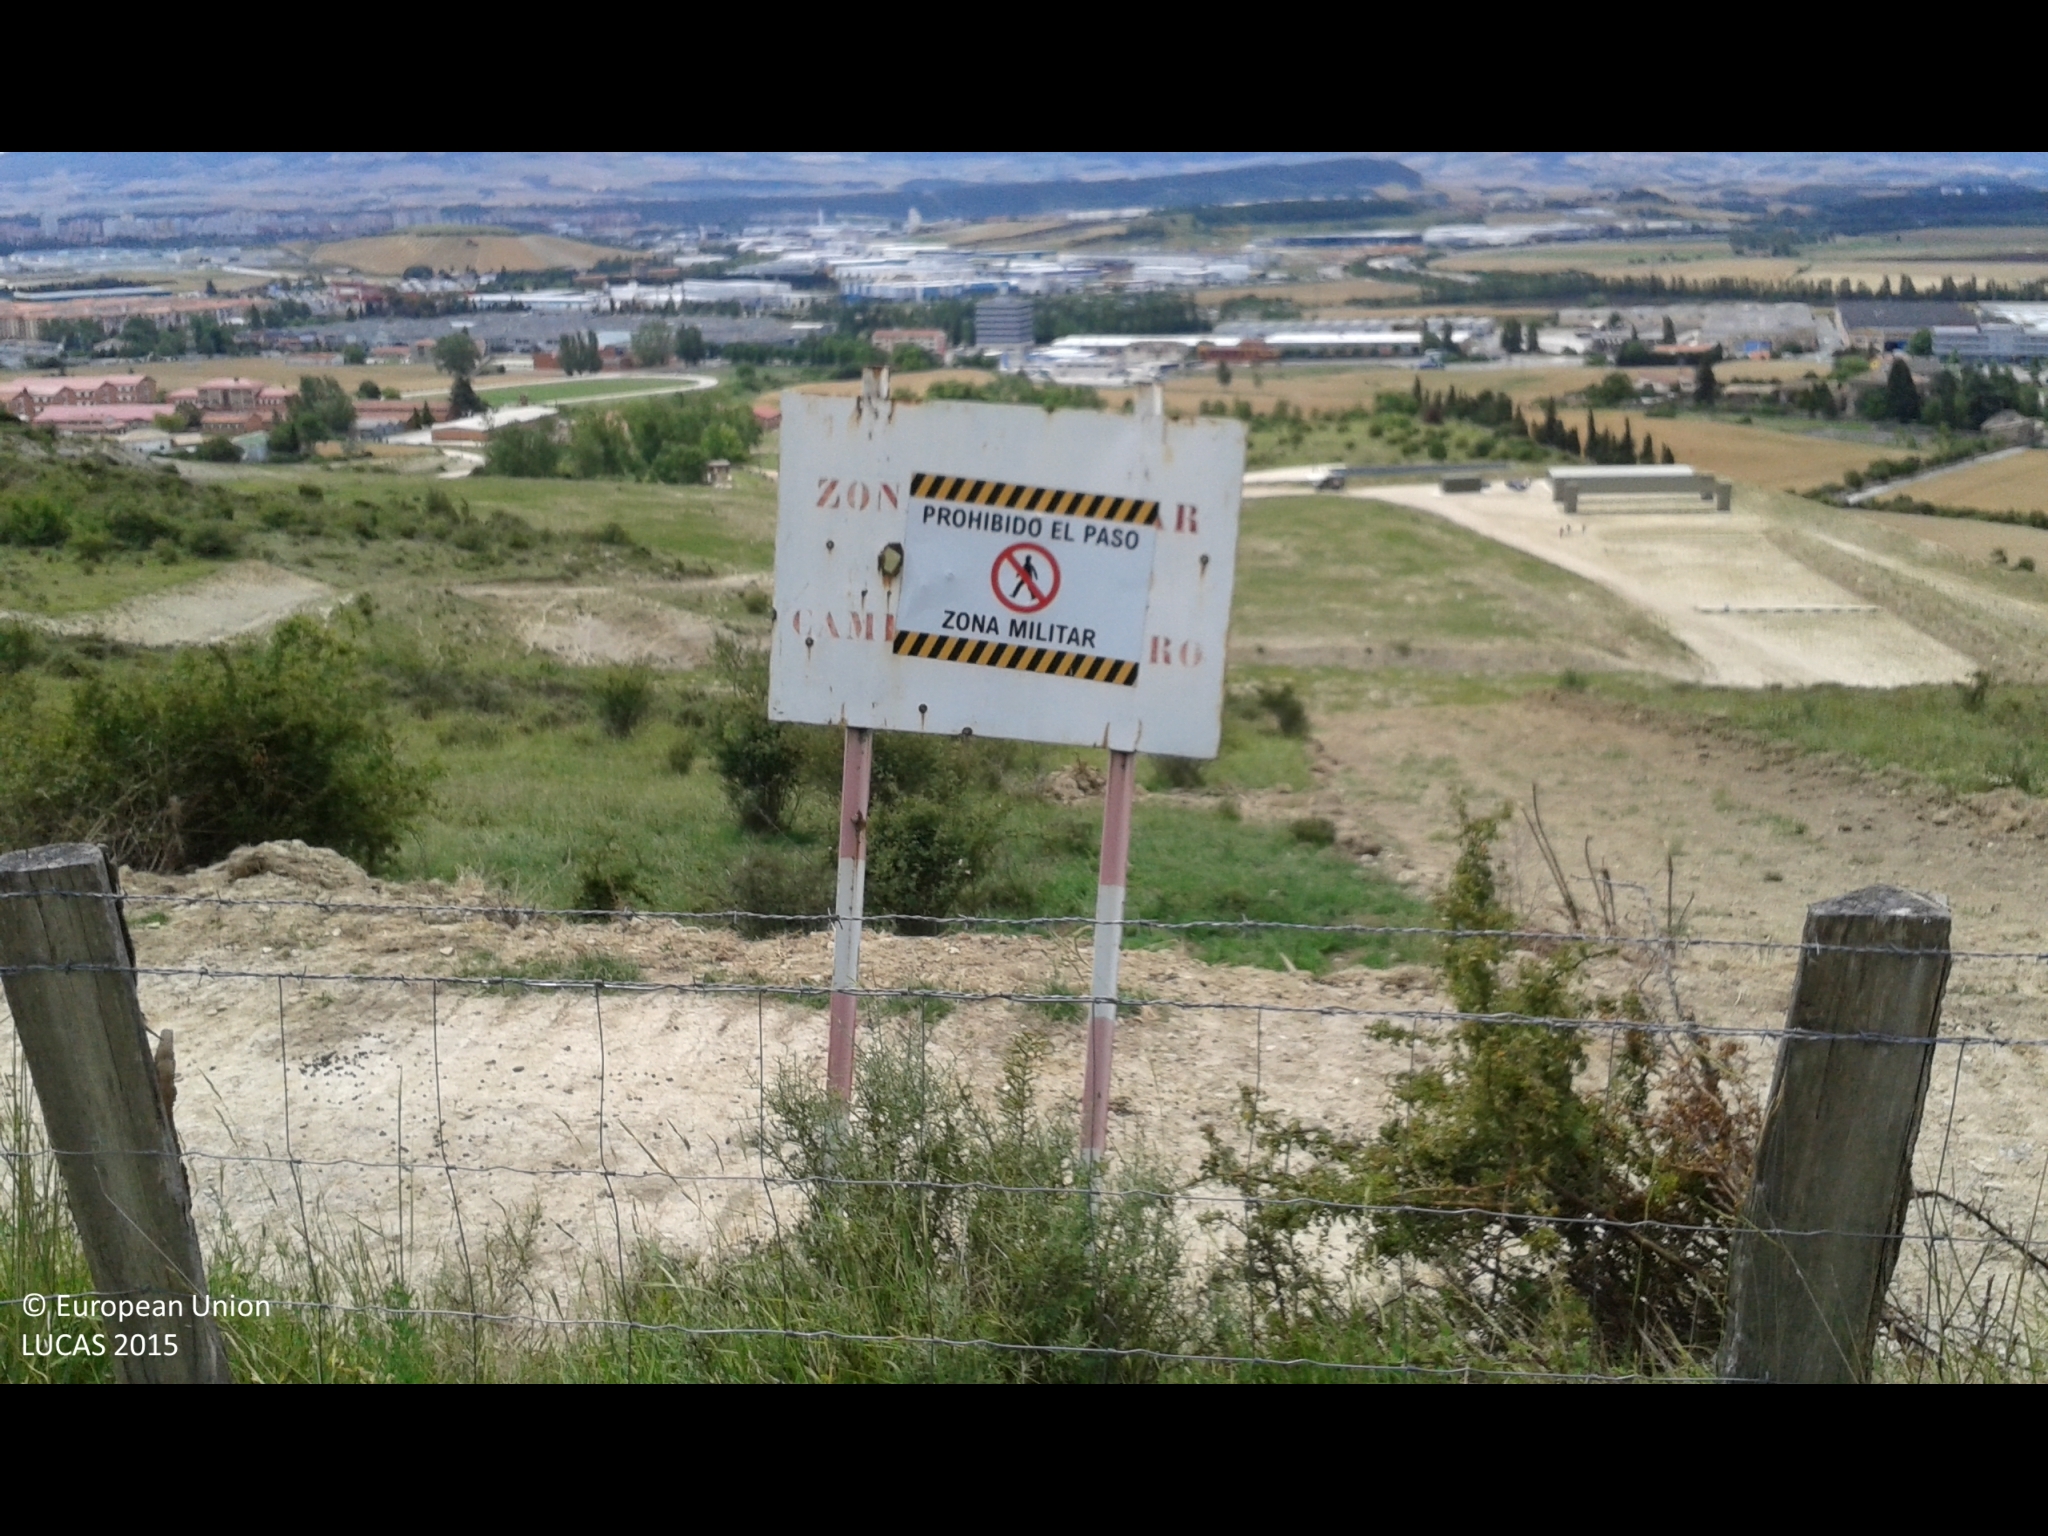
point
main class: Grassland
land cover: Grassland without tree/shrub cover
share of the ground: > 75 %
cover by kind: consolidated bare surface 60 %, herbaceous plants 40 %
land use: Community services
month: June
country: ES
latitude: 42.8510
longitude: -1.6773
